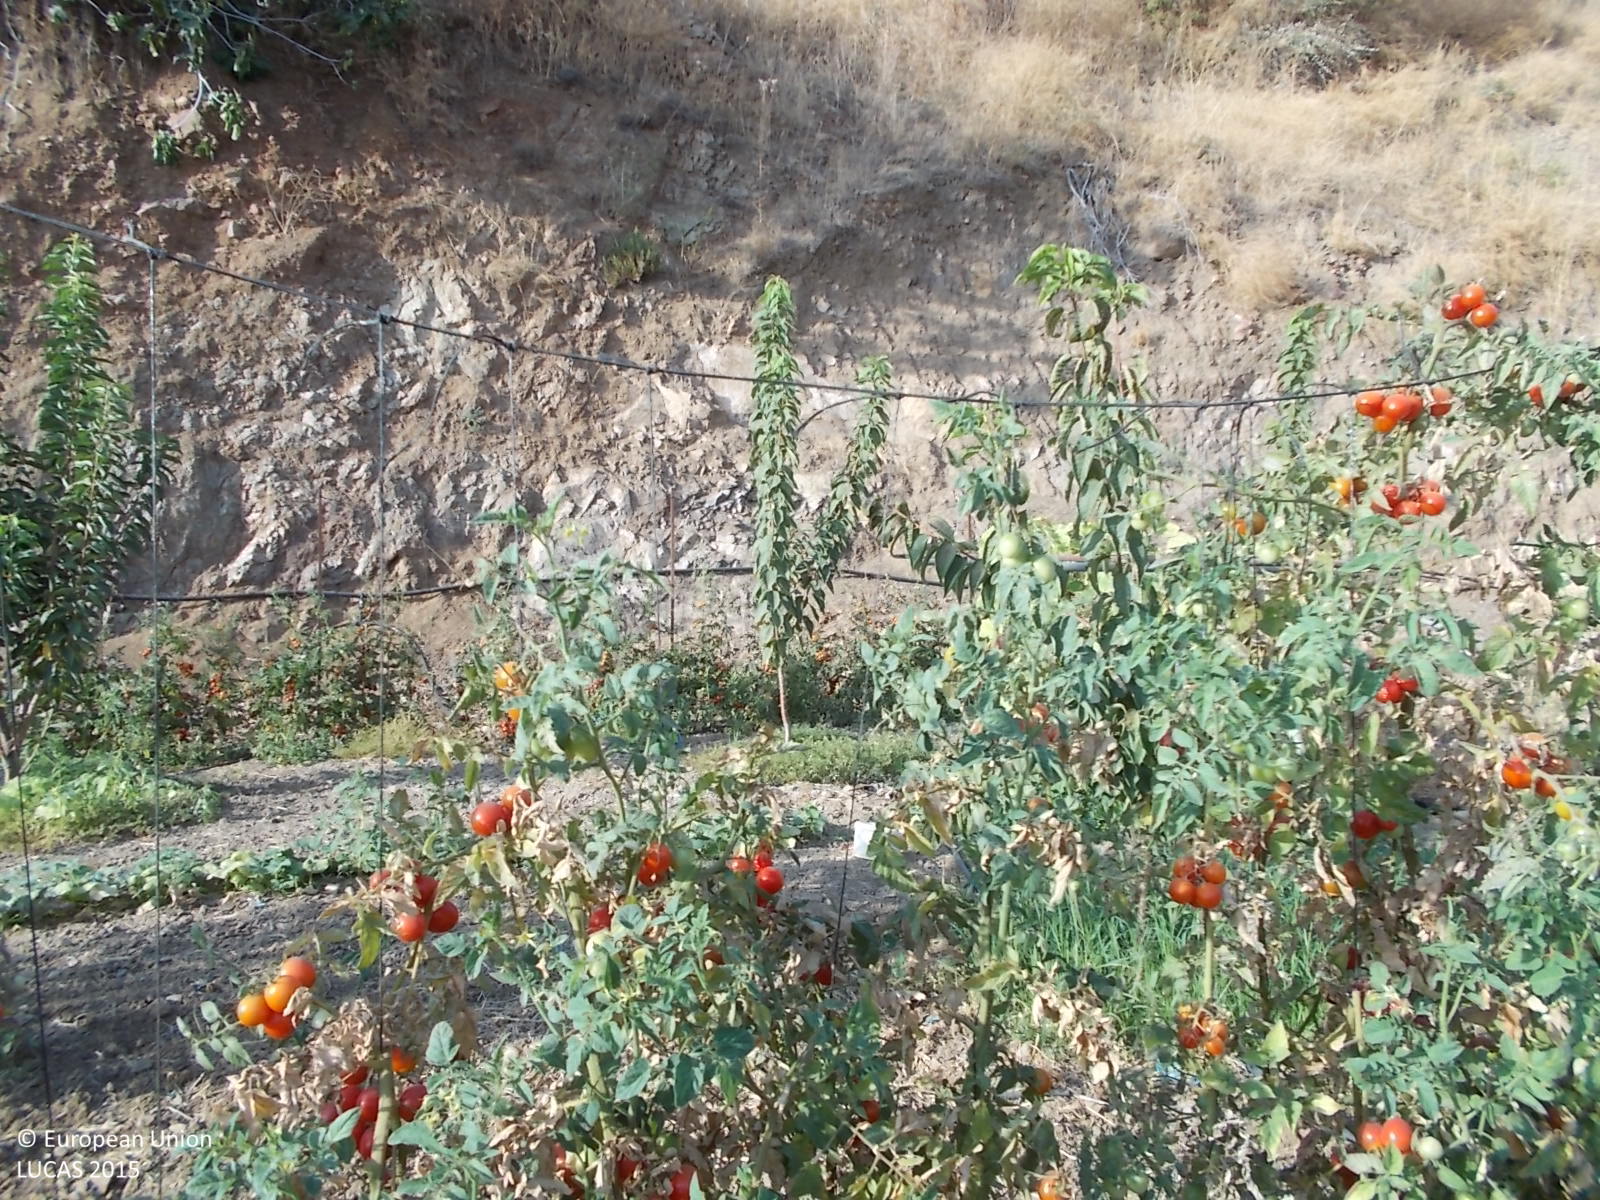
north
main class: Cropland
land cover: Tomatoes
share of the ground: 10 - 25 %
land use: Agriculture (excluding fallow land and kitchen gardens)
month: April
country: CY
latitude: 34.8778
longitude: 33.1849
